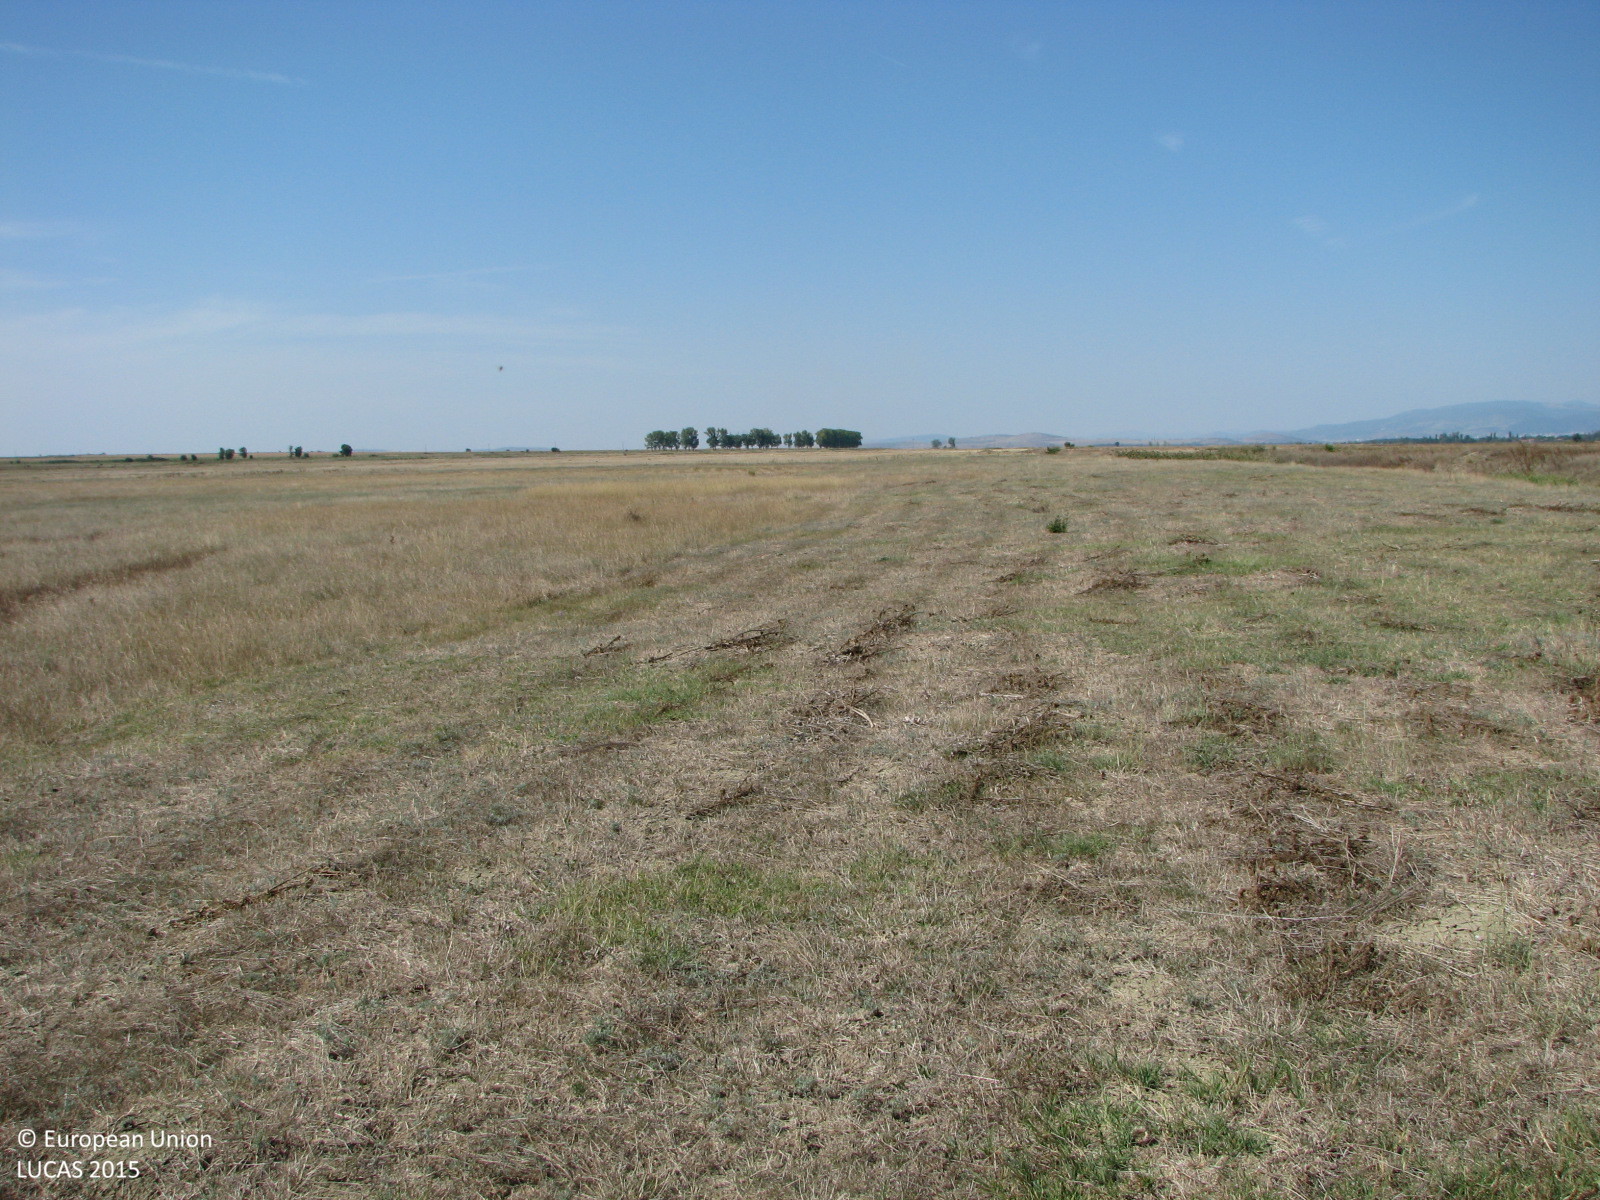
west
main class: Grassland
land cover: Grassland without tree/shrub cover
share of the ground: > 75 %
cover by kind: herbaceous plants 100 %
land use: Agriculture (excluding fallow land and kitchen gardens)
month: September
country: BG
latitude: 42.6174
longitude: 26.5909
